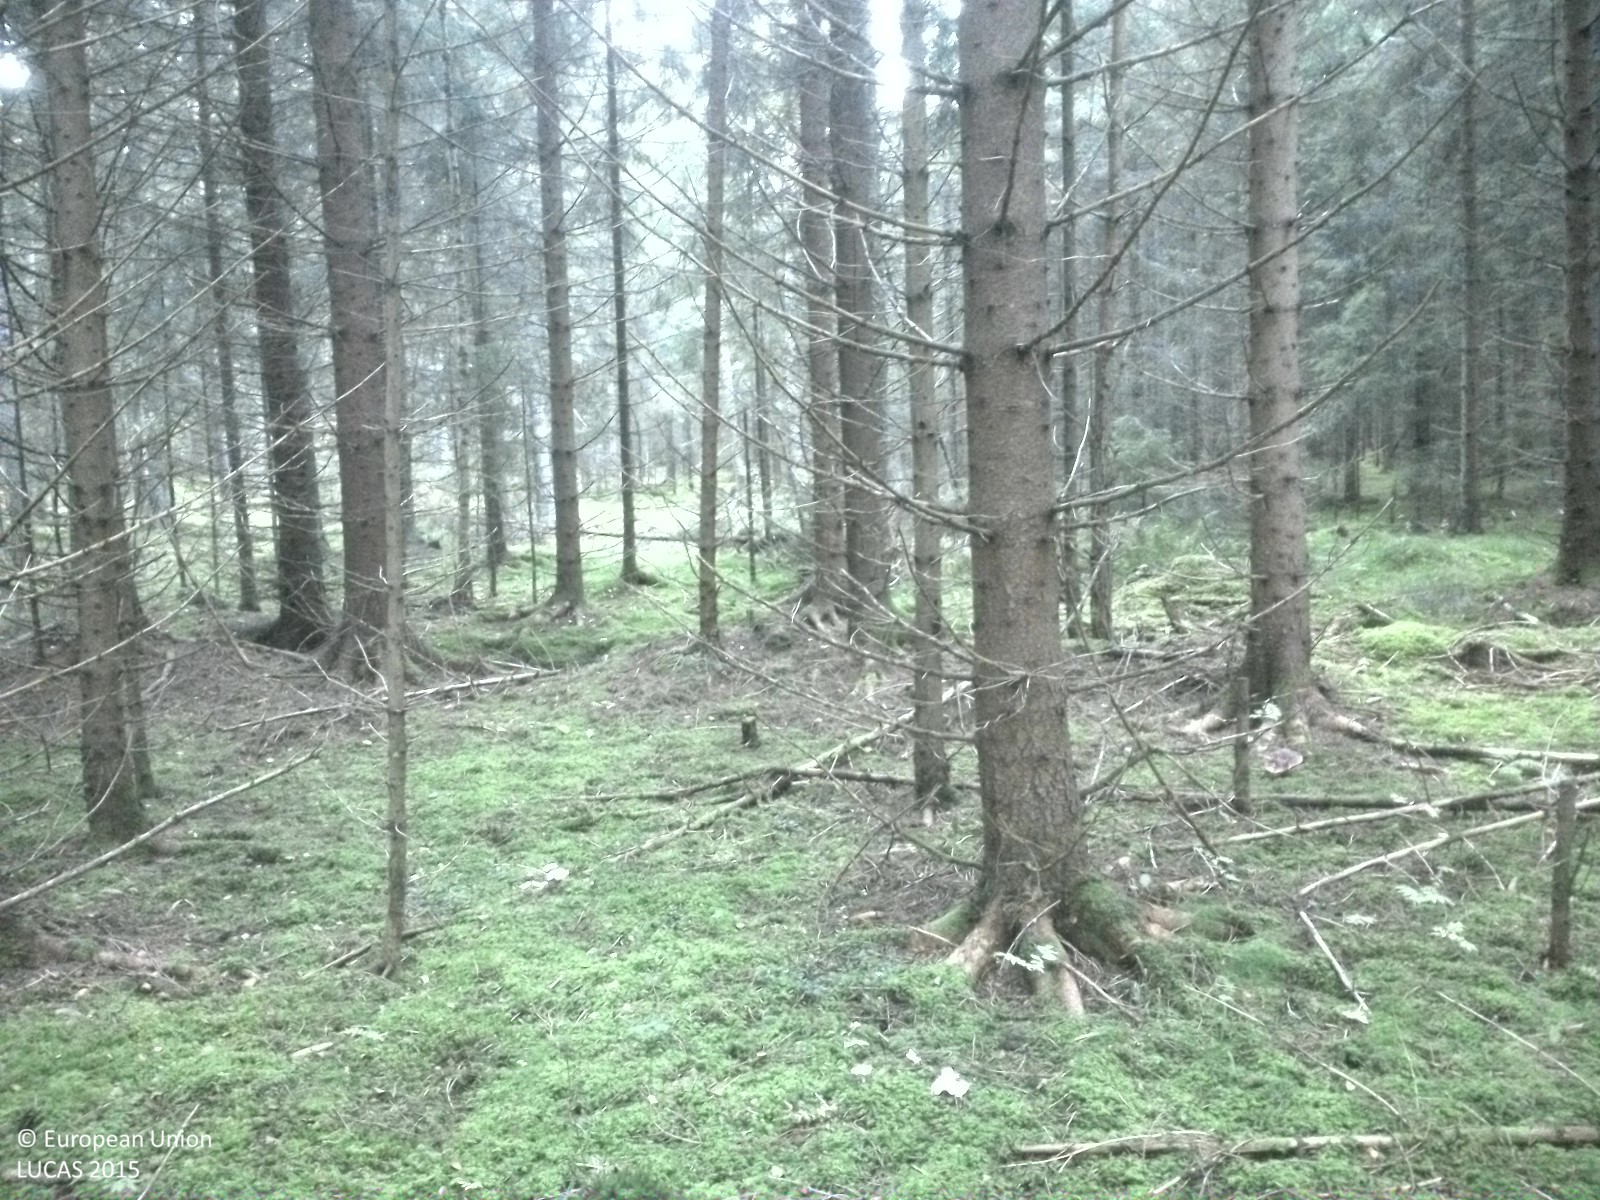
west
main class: Woodland
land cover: Spruce dominated coniferous woodland
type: boreal forest
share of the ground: 50 - 75 %
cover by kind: coniferous forest trees 60 %, lichens and mosses 35 %, herbaceous plants 5 %
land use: Forestry
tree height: > 5 m
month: September
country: SE
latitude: 58.7332
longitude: 16.4383
